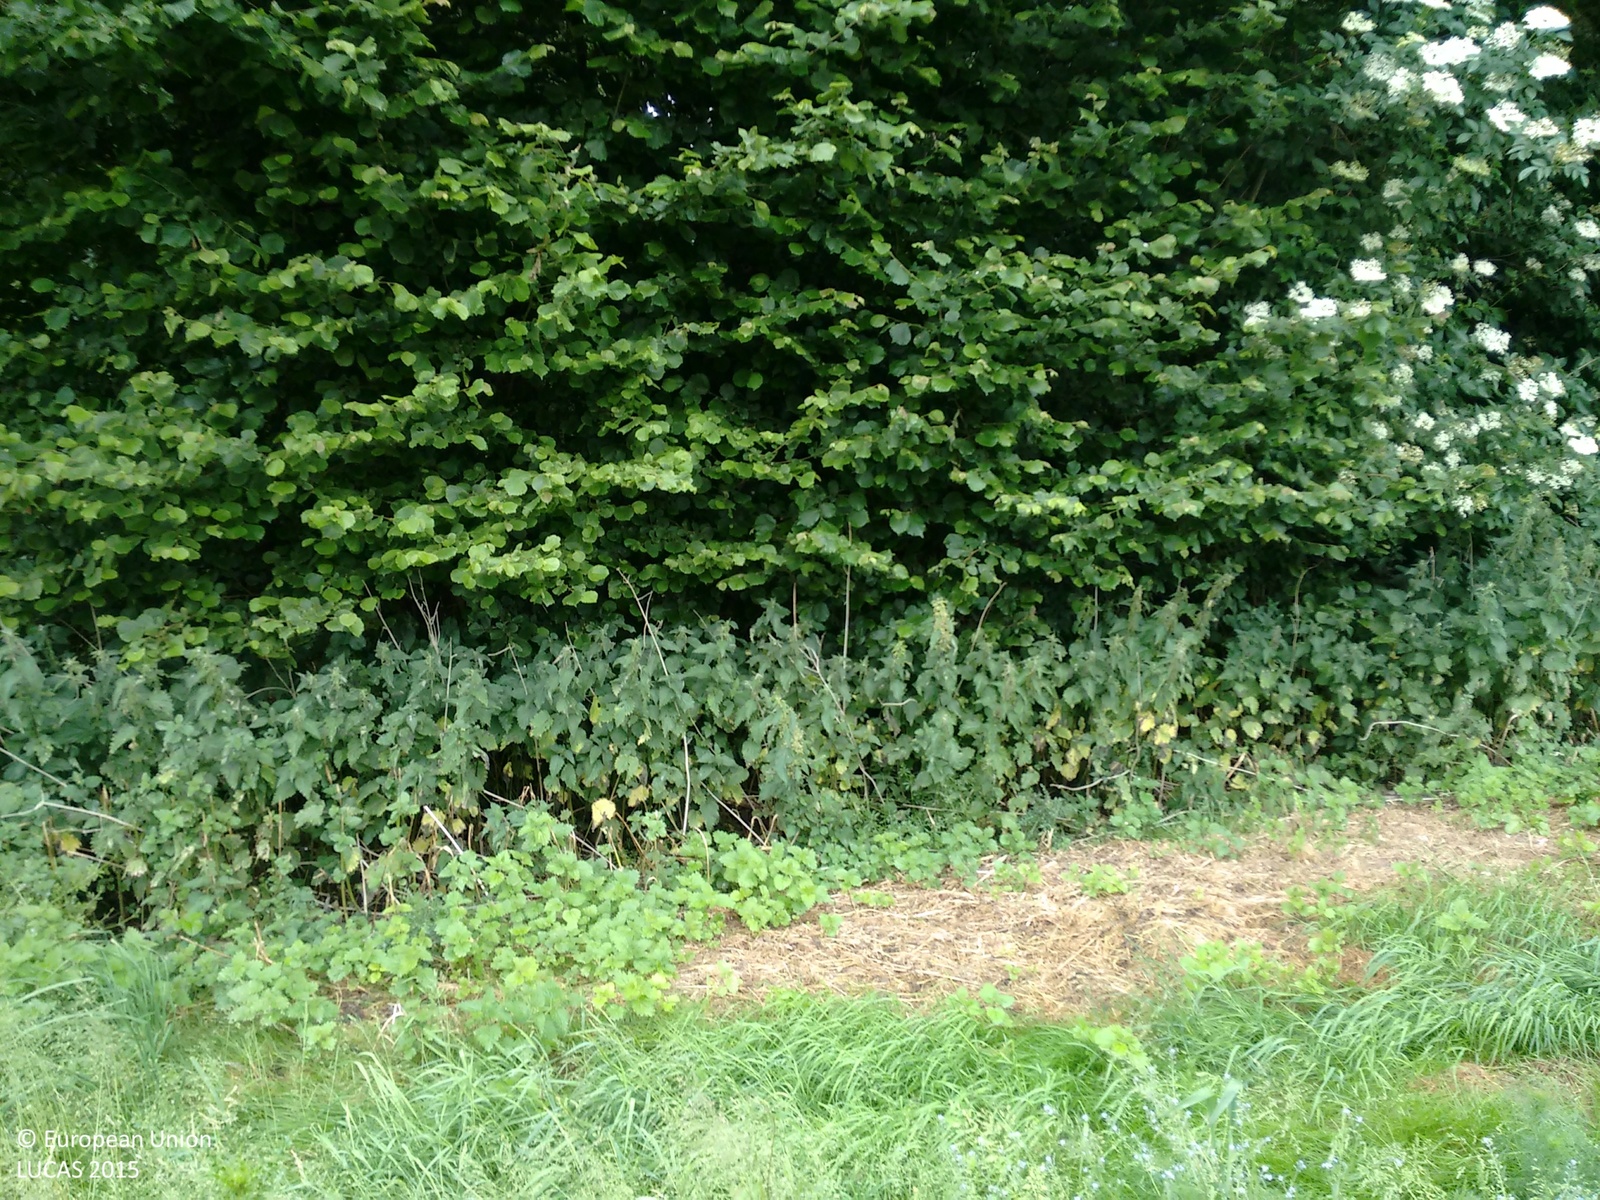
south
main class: Cropland
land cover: Rape and turnip rape
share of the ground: > 75 %
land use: Agriculture (excluding fallow land and kitchen gardens)
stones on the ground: < 10 %
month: June
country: GB
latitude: 51.4900
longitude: -1.1215
